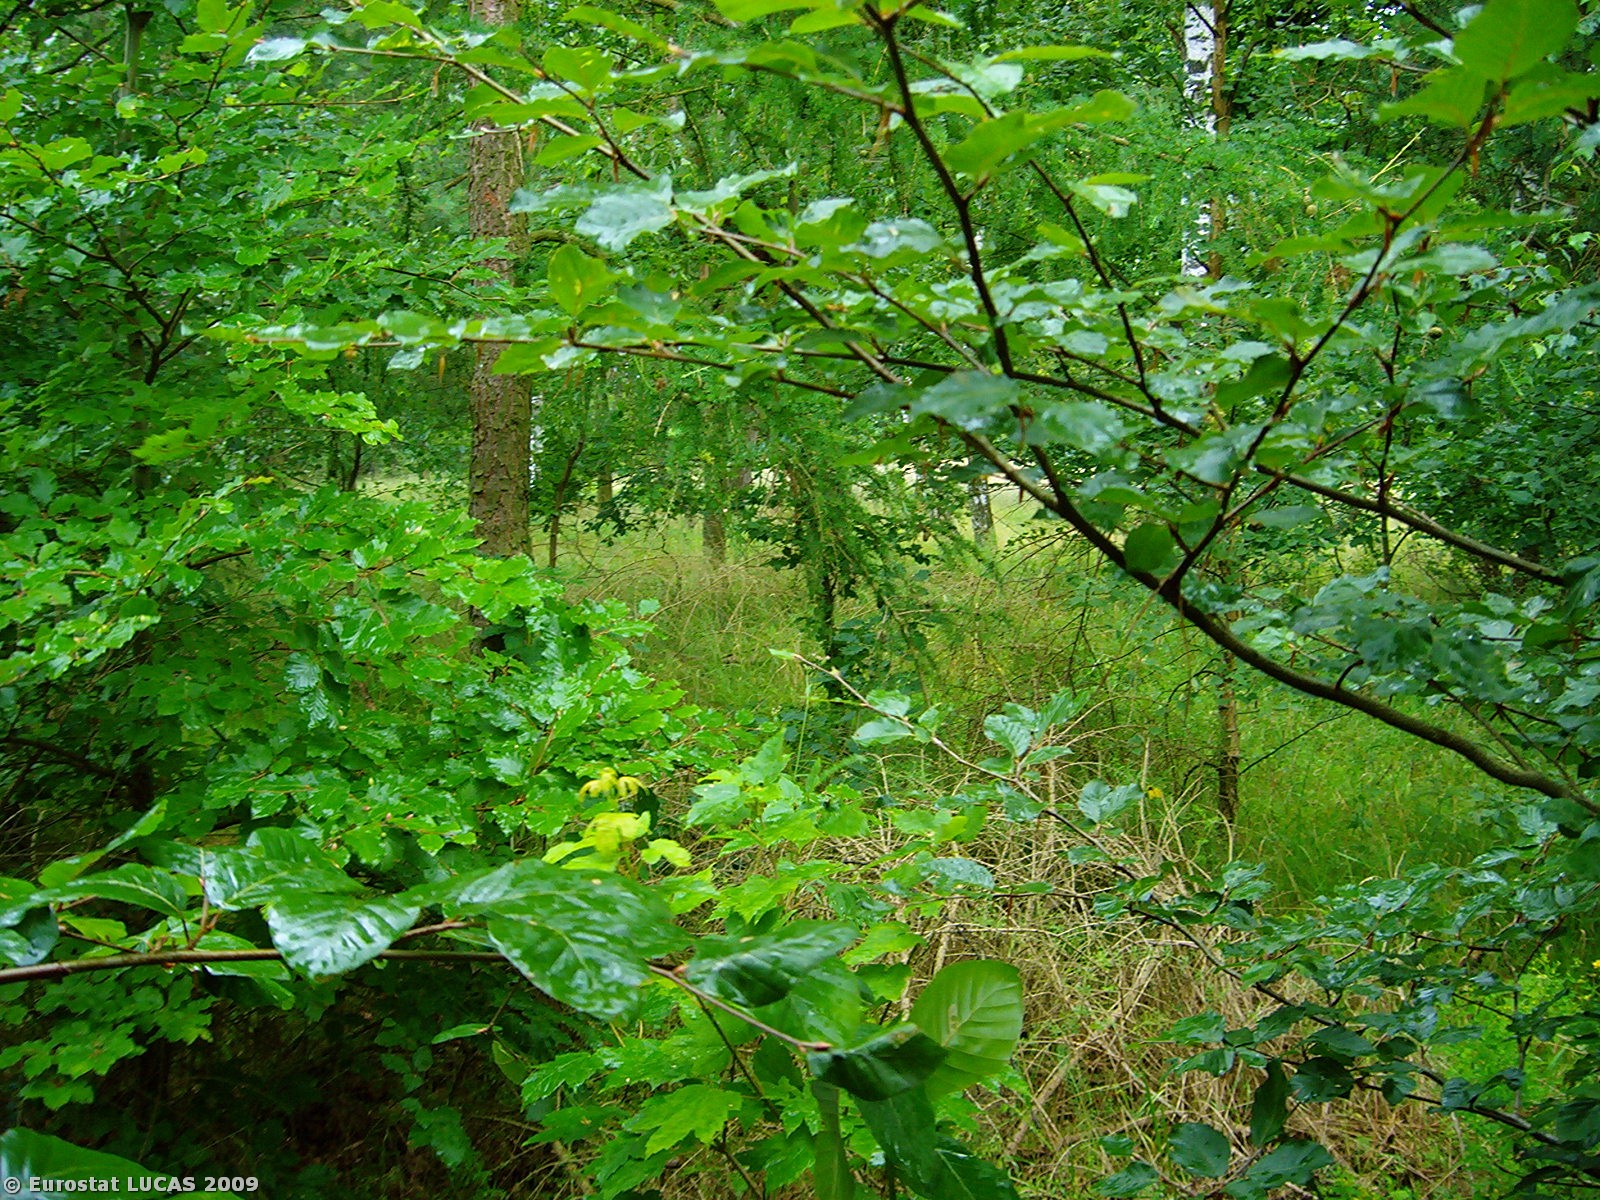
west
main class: Woodland
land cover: Mixed woodland
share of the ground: > 75 %
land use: Unused
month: July
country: PL
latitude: 52.3093
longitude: 15.3866
